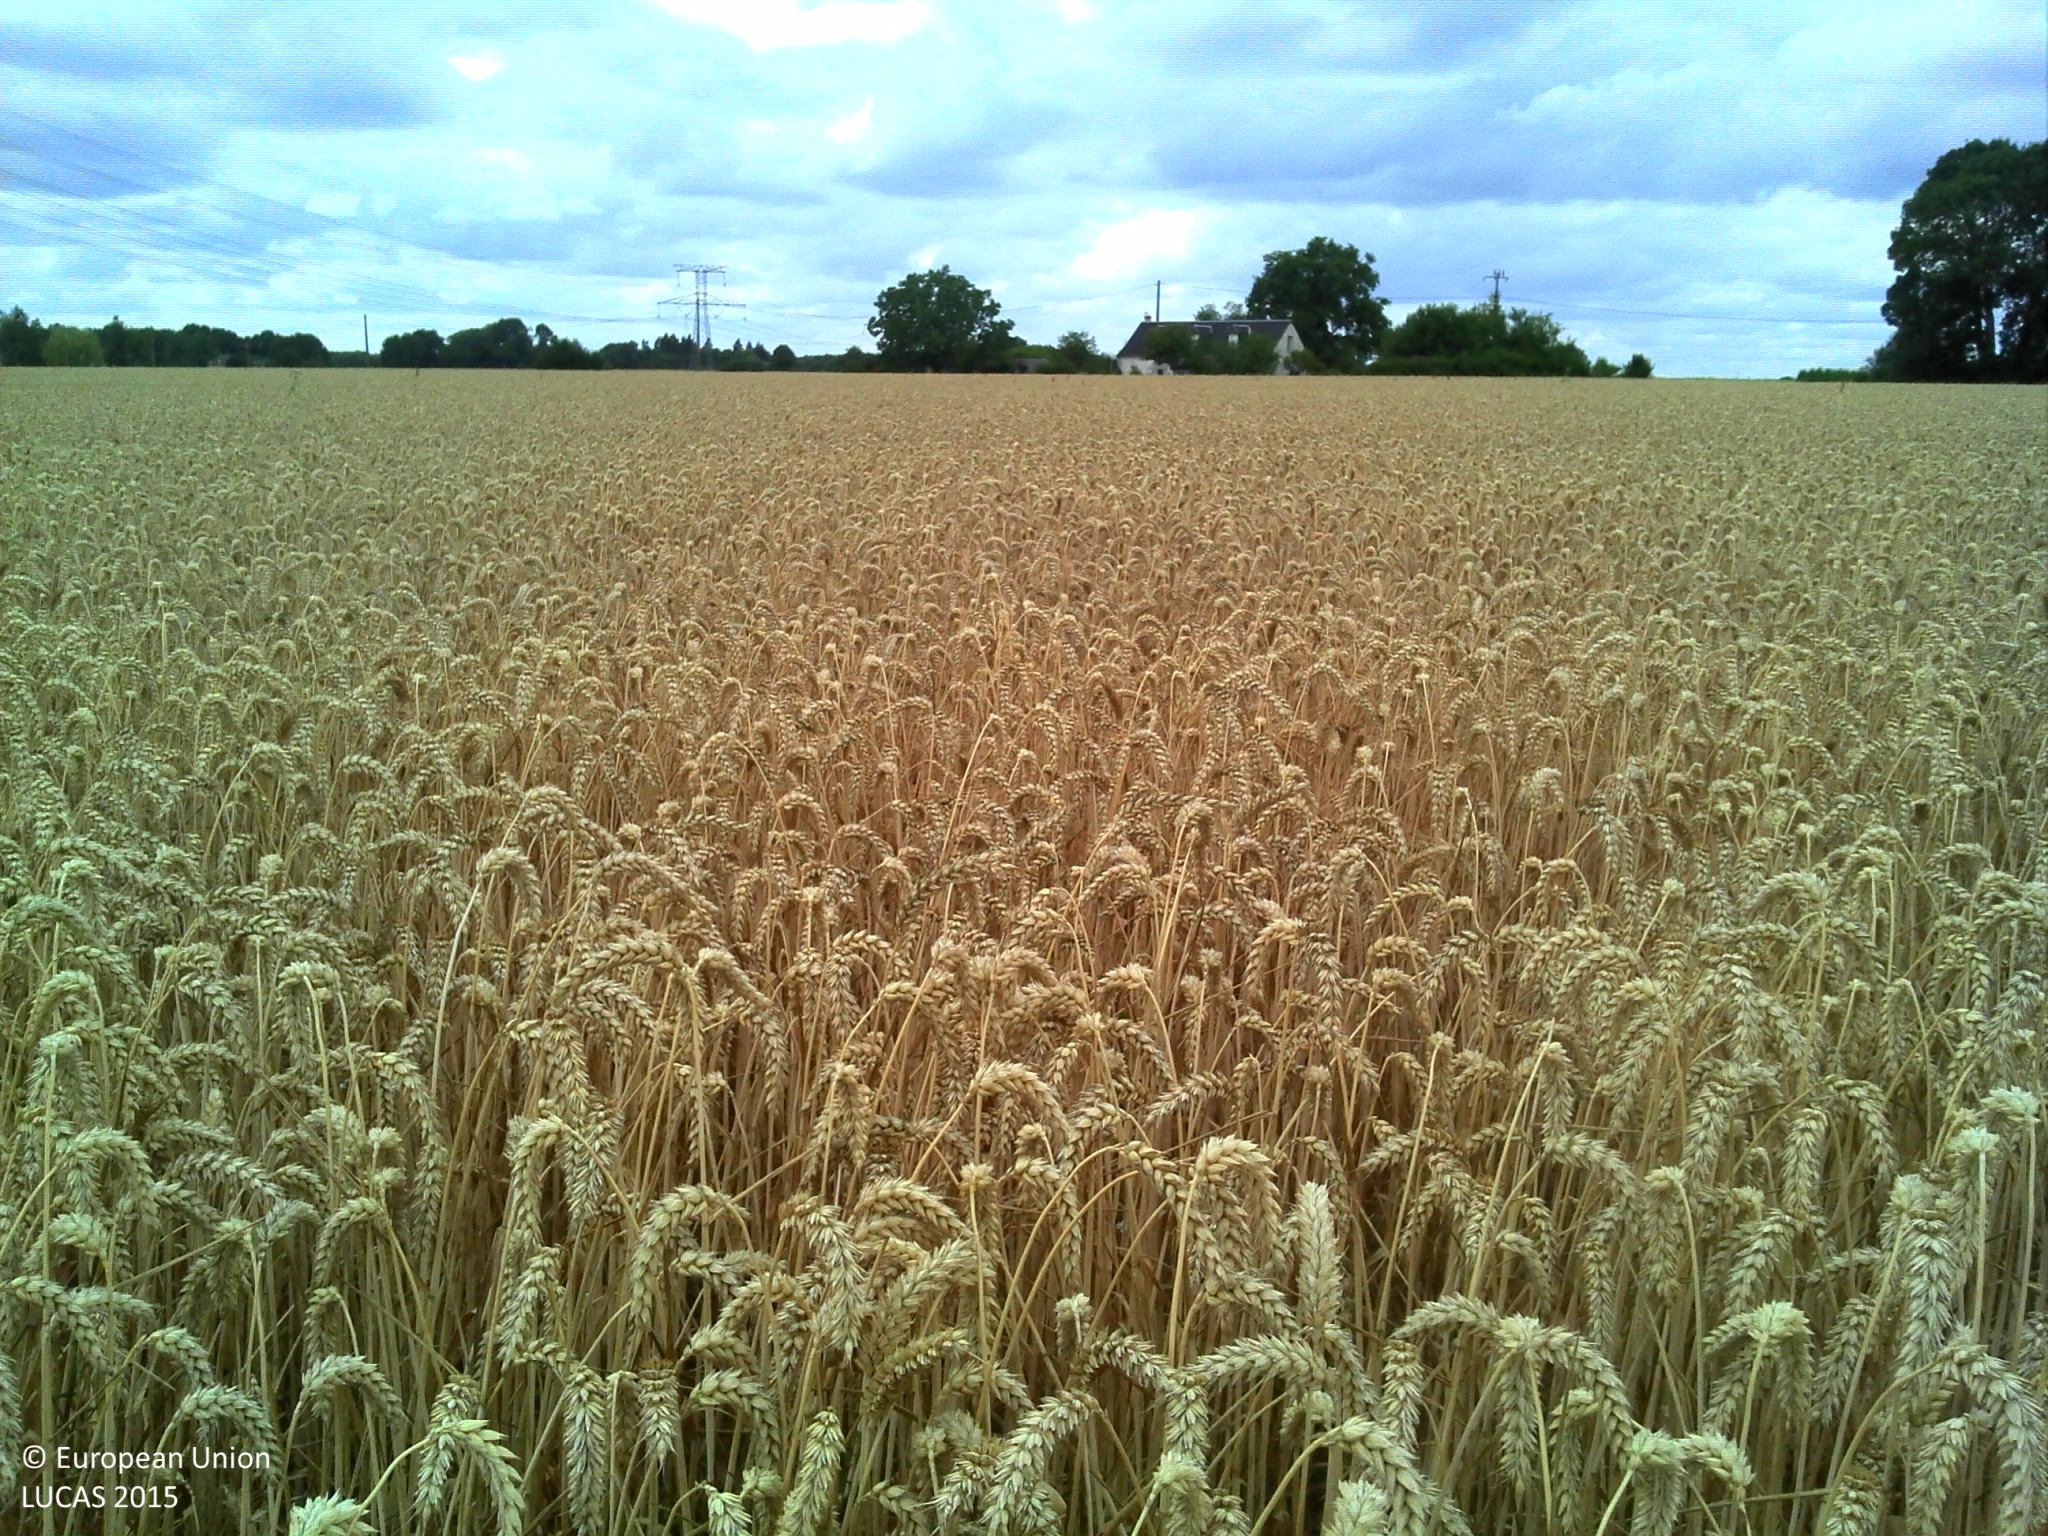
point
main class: Cropland
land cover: Common wheat
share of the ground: > 75 %
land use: Agriculture (excluding fallow land and kitchen gardens)
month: July
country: FR
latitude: 47.7171
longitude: 0.4462
